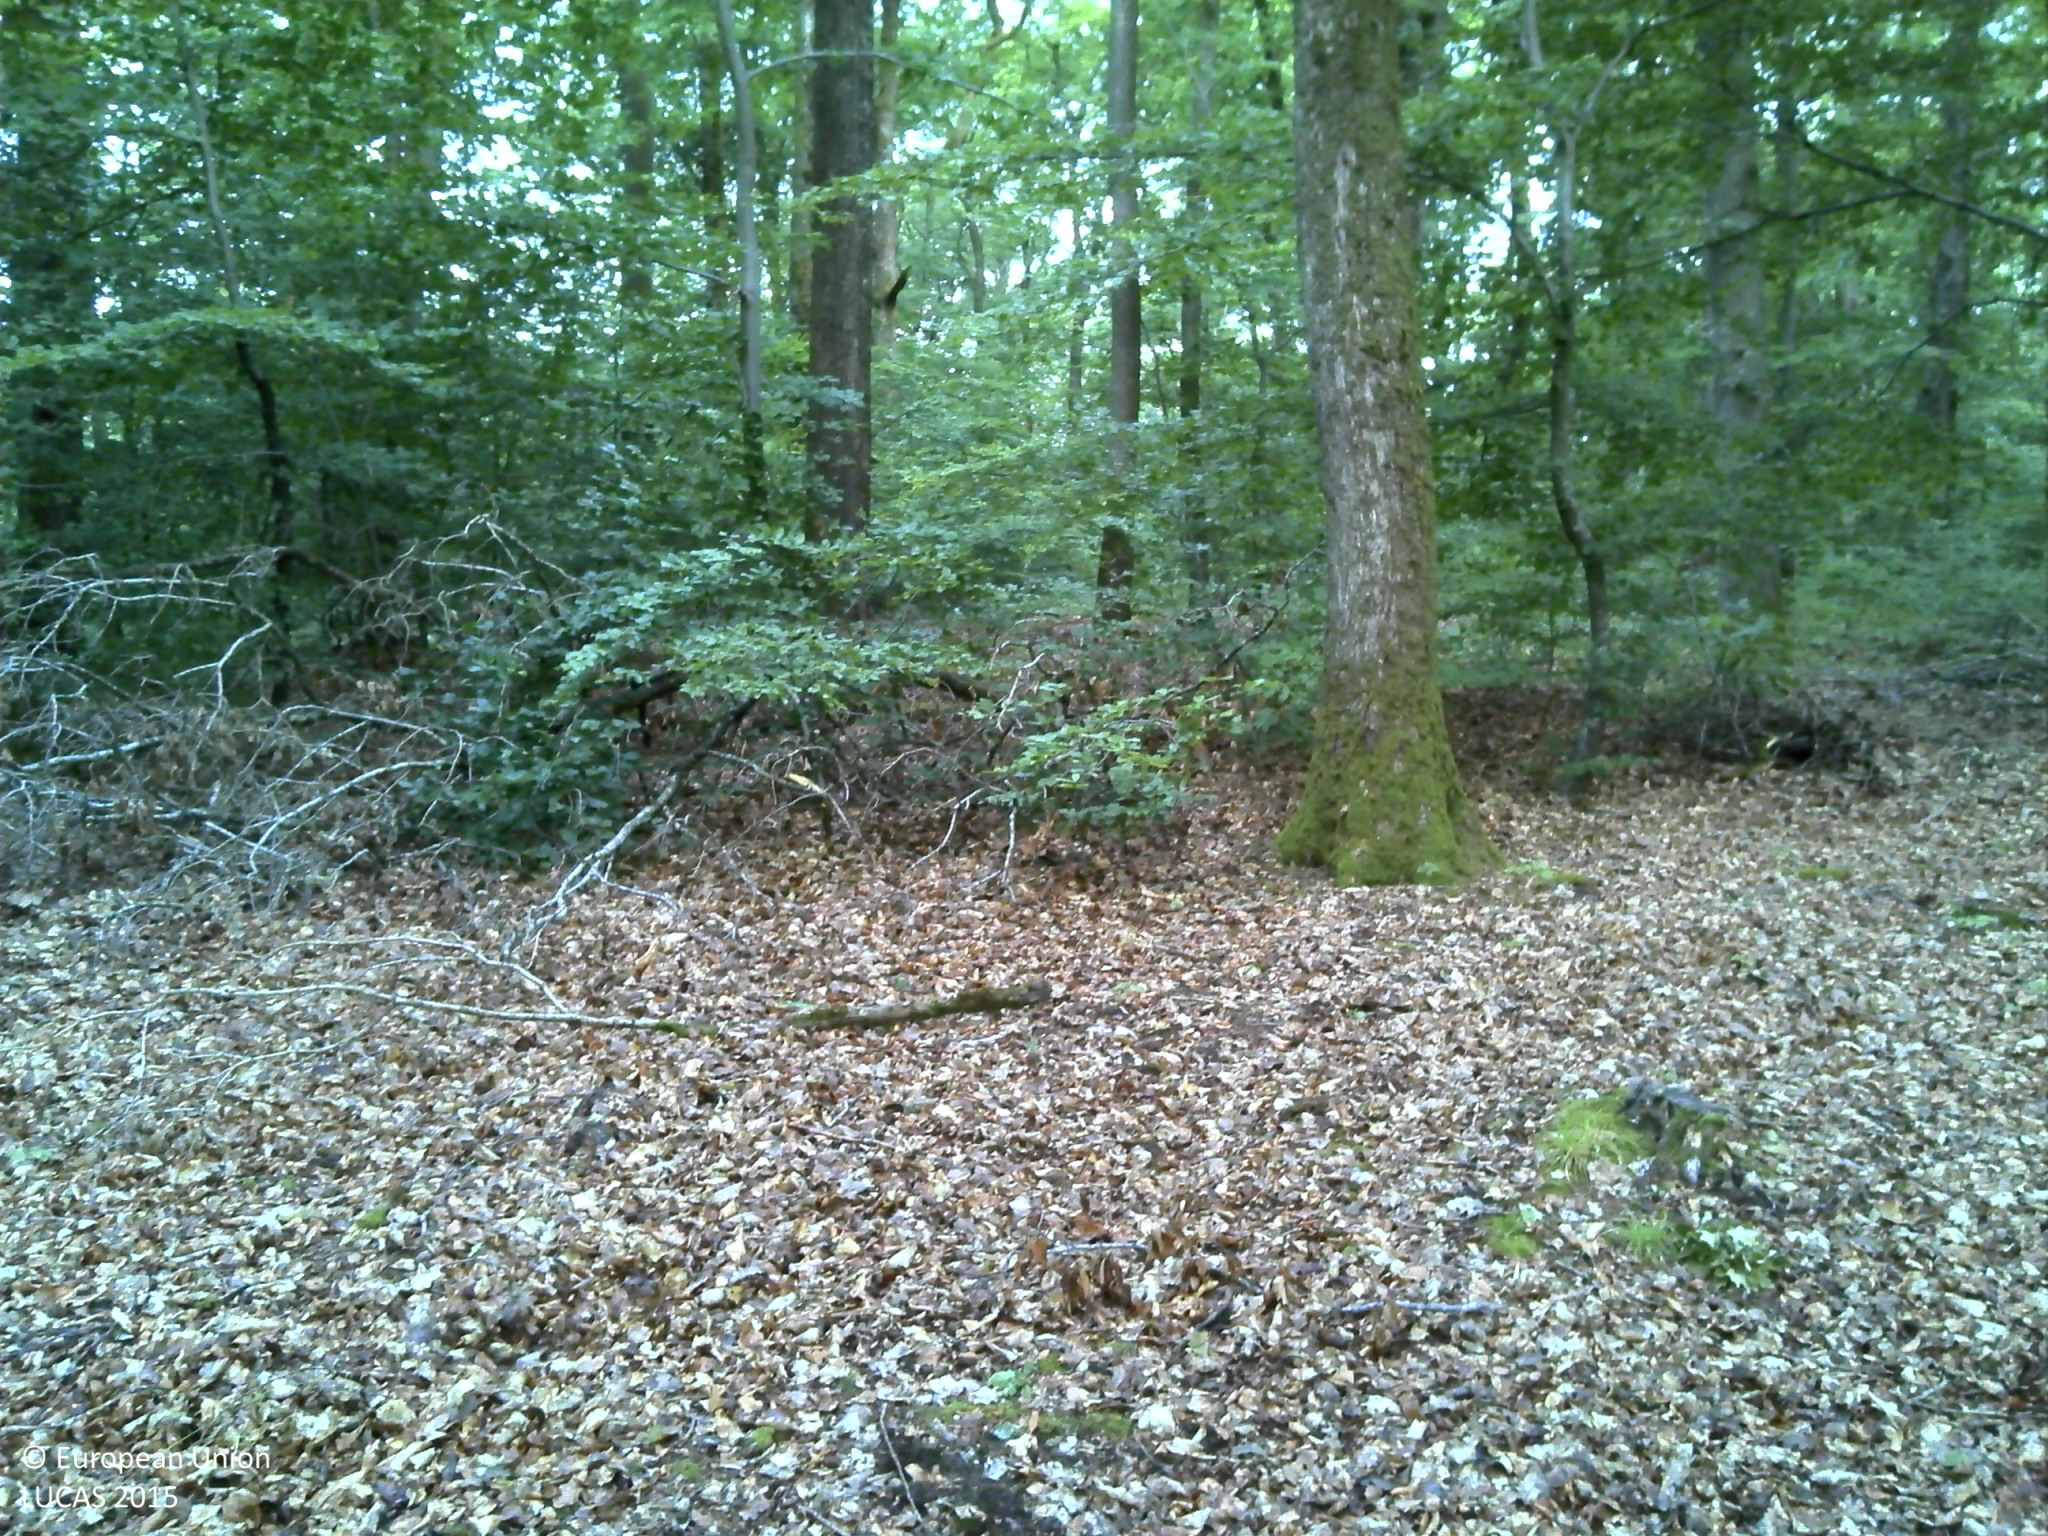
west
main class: Woodland
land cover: Broadleaved woodland
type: beech forest
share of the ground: > 75 %
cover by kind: broadleaved forest trees 80 %, unconsolidated bare surface 20 %
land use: Forestry
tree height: > 5 m
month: July
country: FR
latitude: 48.2505
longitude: 6.2699
